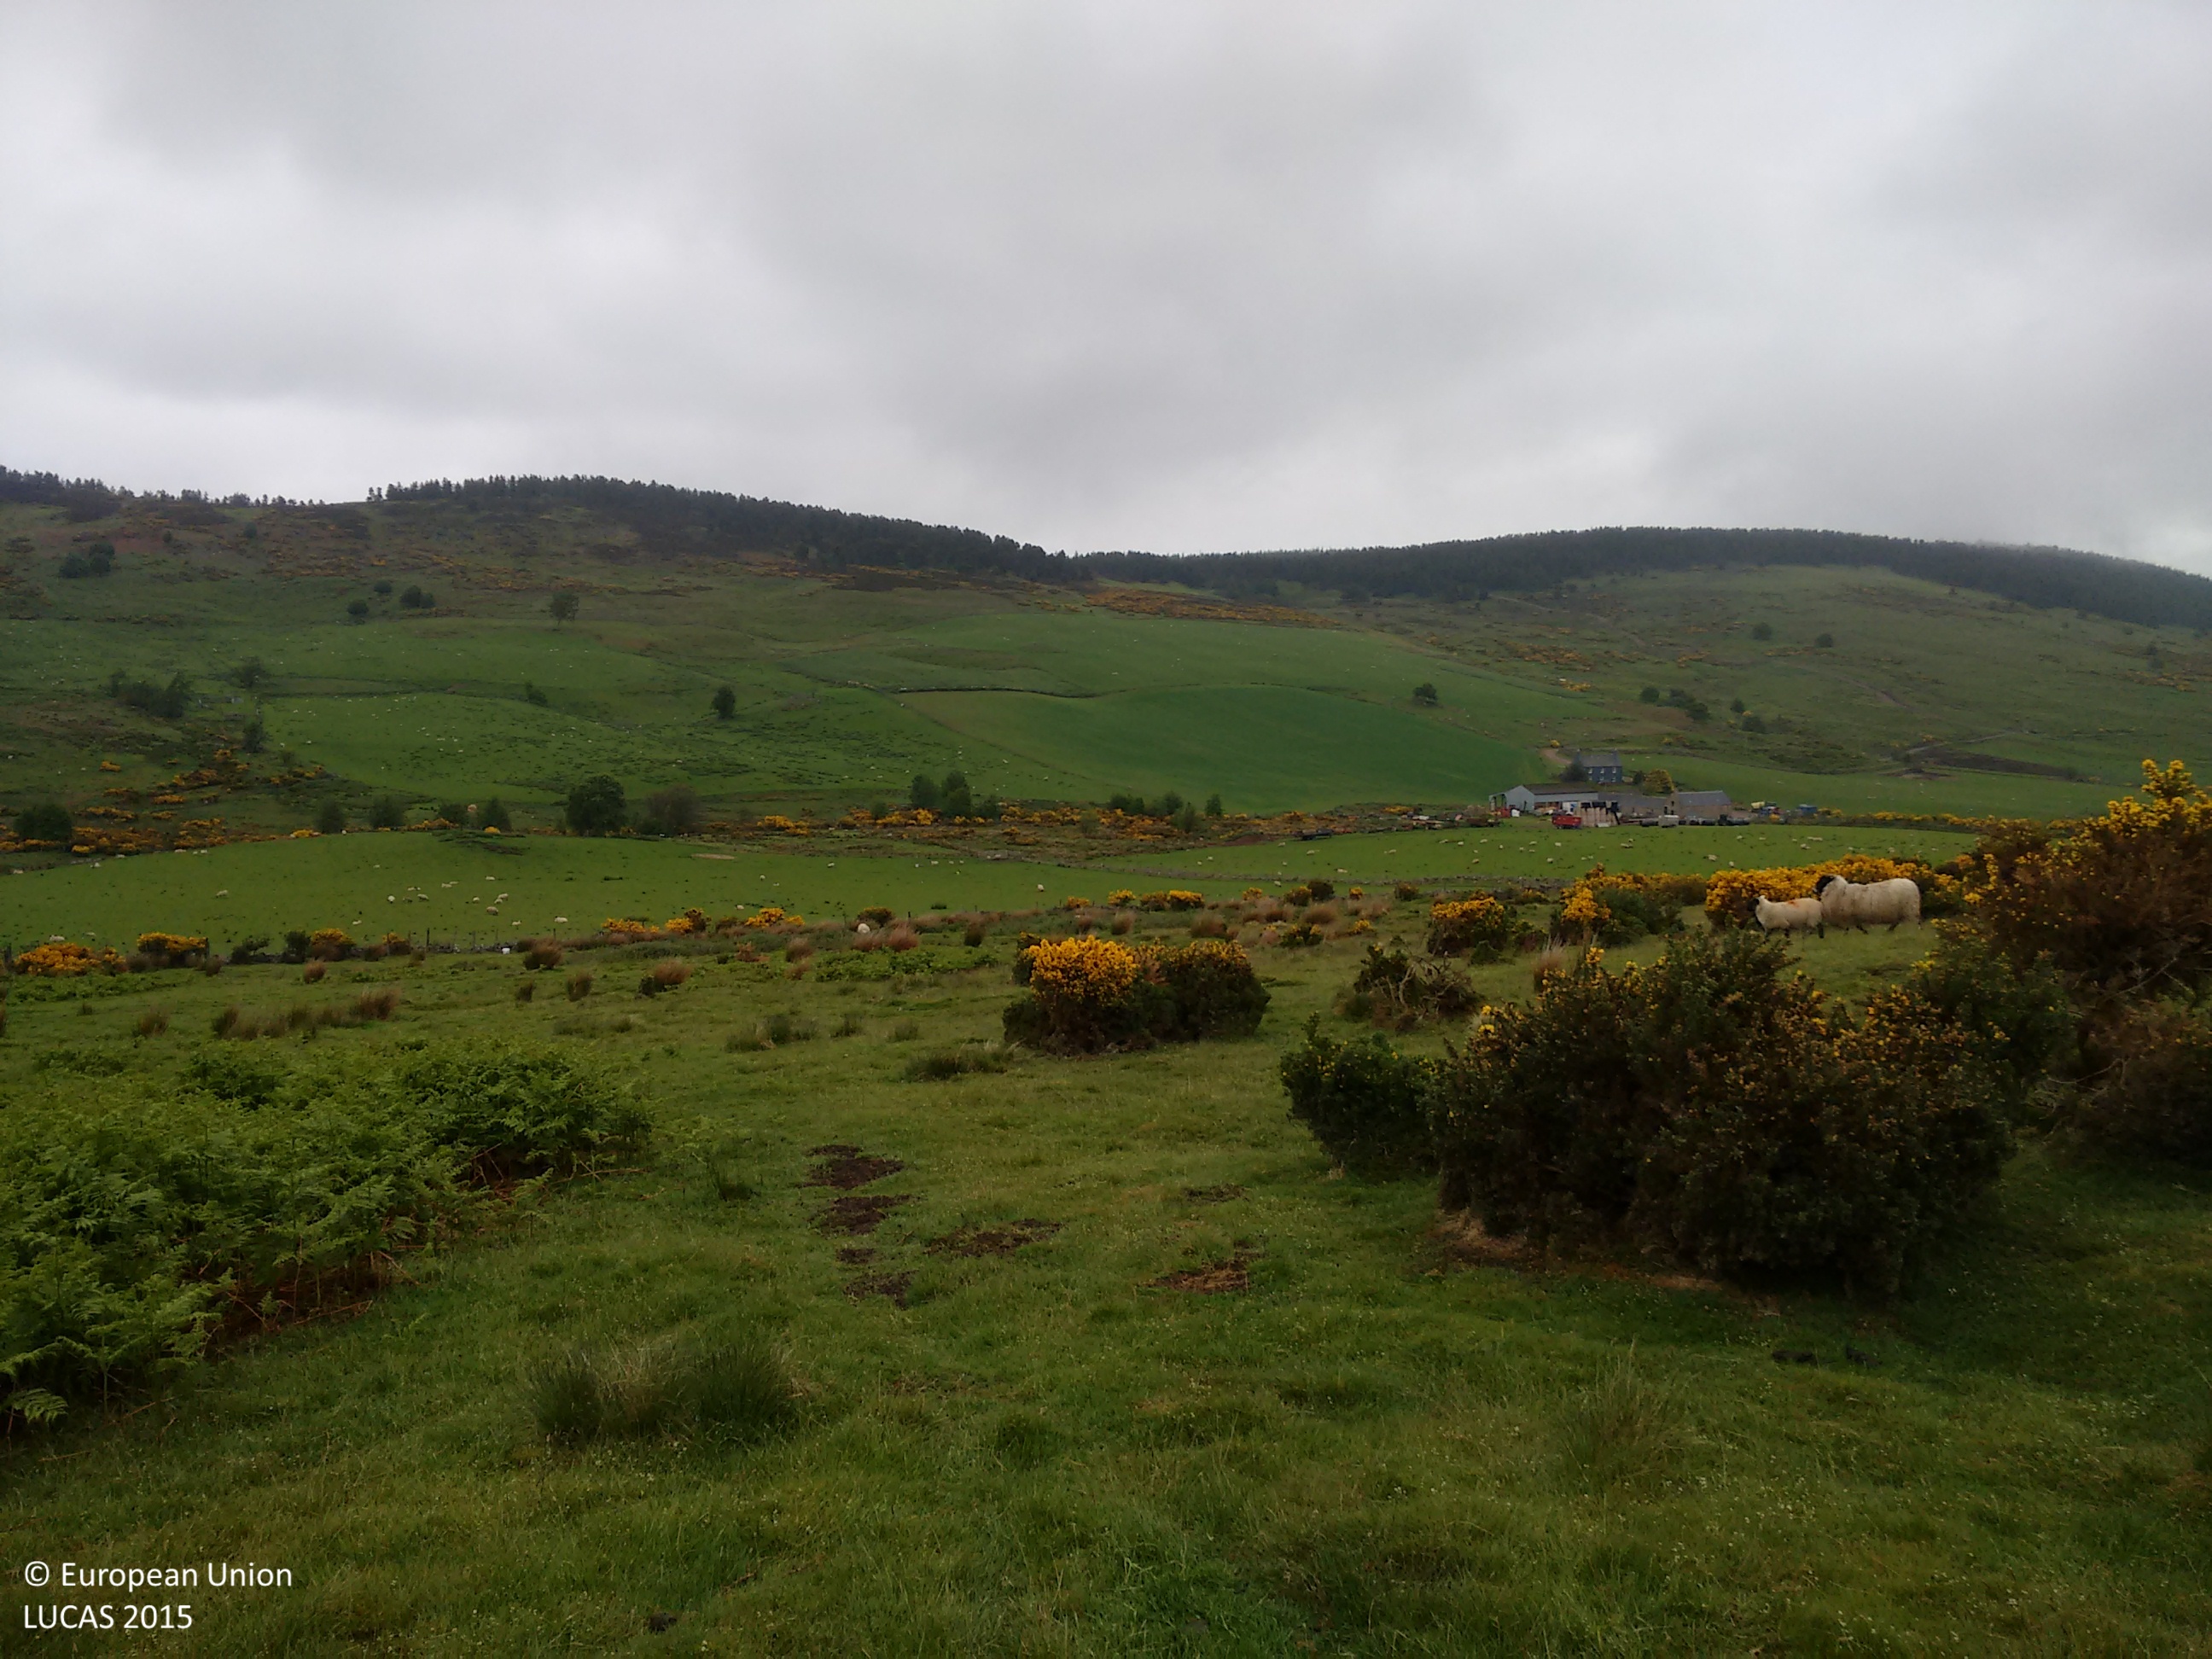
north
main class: Grassland
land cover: Grassland without tree/shrub cover
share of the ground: > 75 %
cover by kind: herbaceous plants 95 %, shrubs 5 %
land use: Agriculture (excluding fallow land and kitchen gardens)
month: June
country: GB
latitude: 57.0243
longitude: -2.7603
